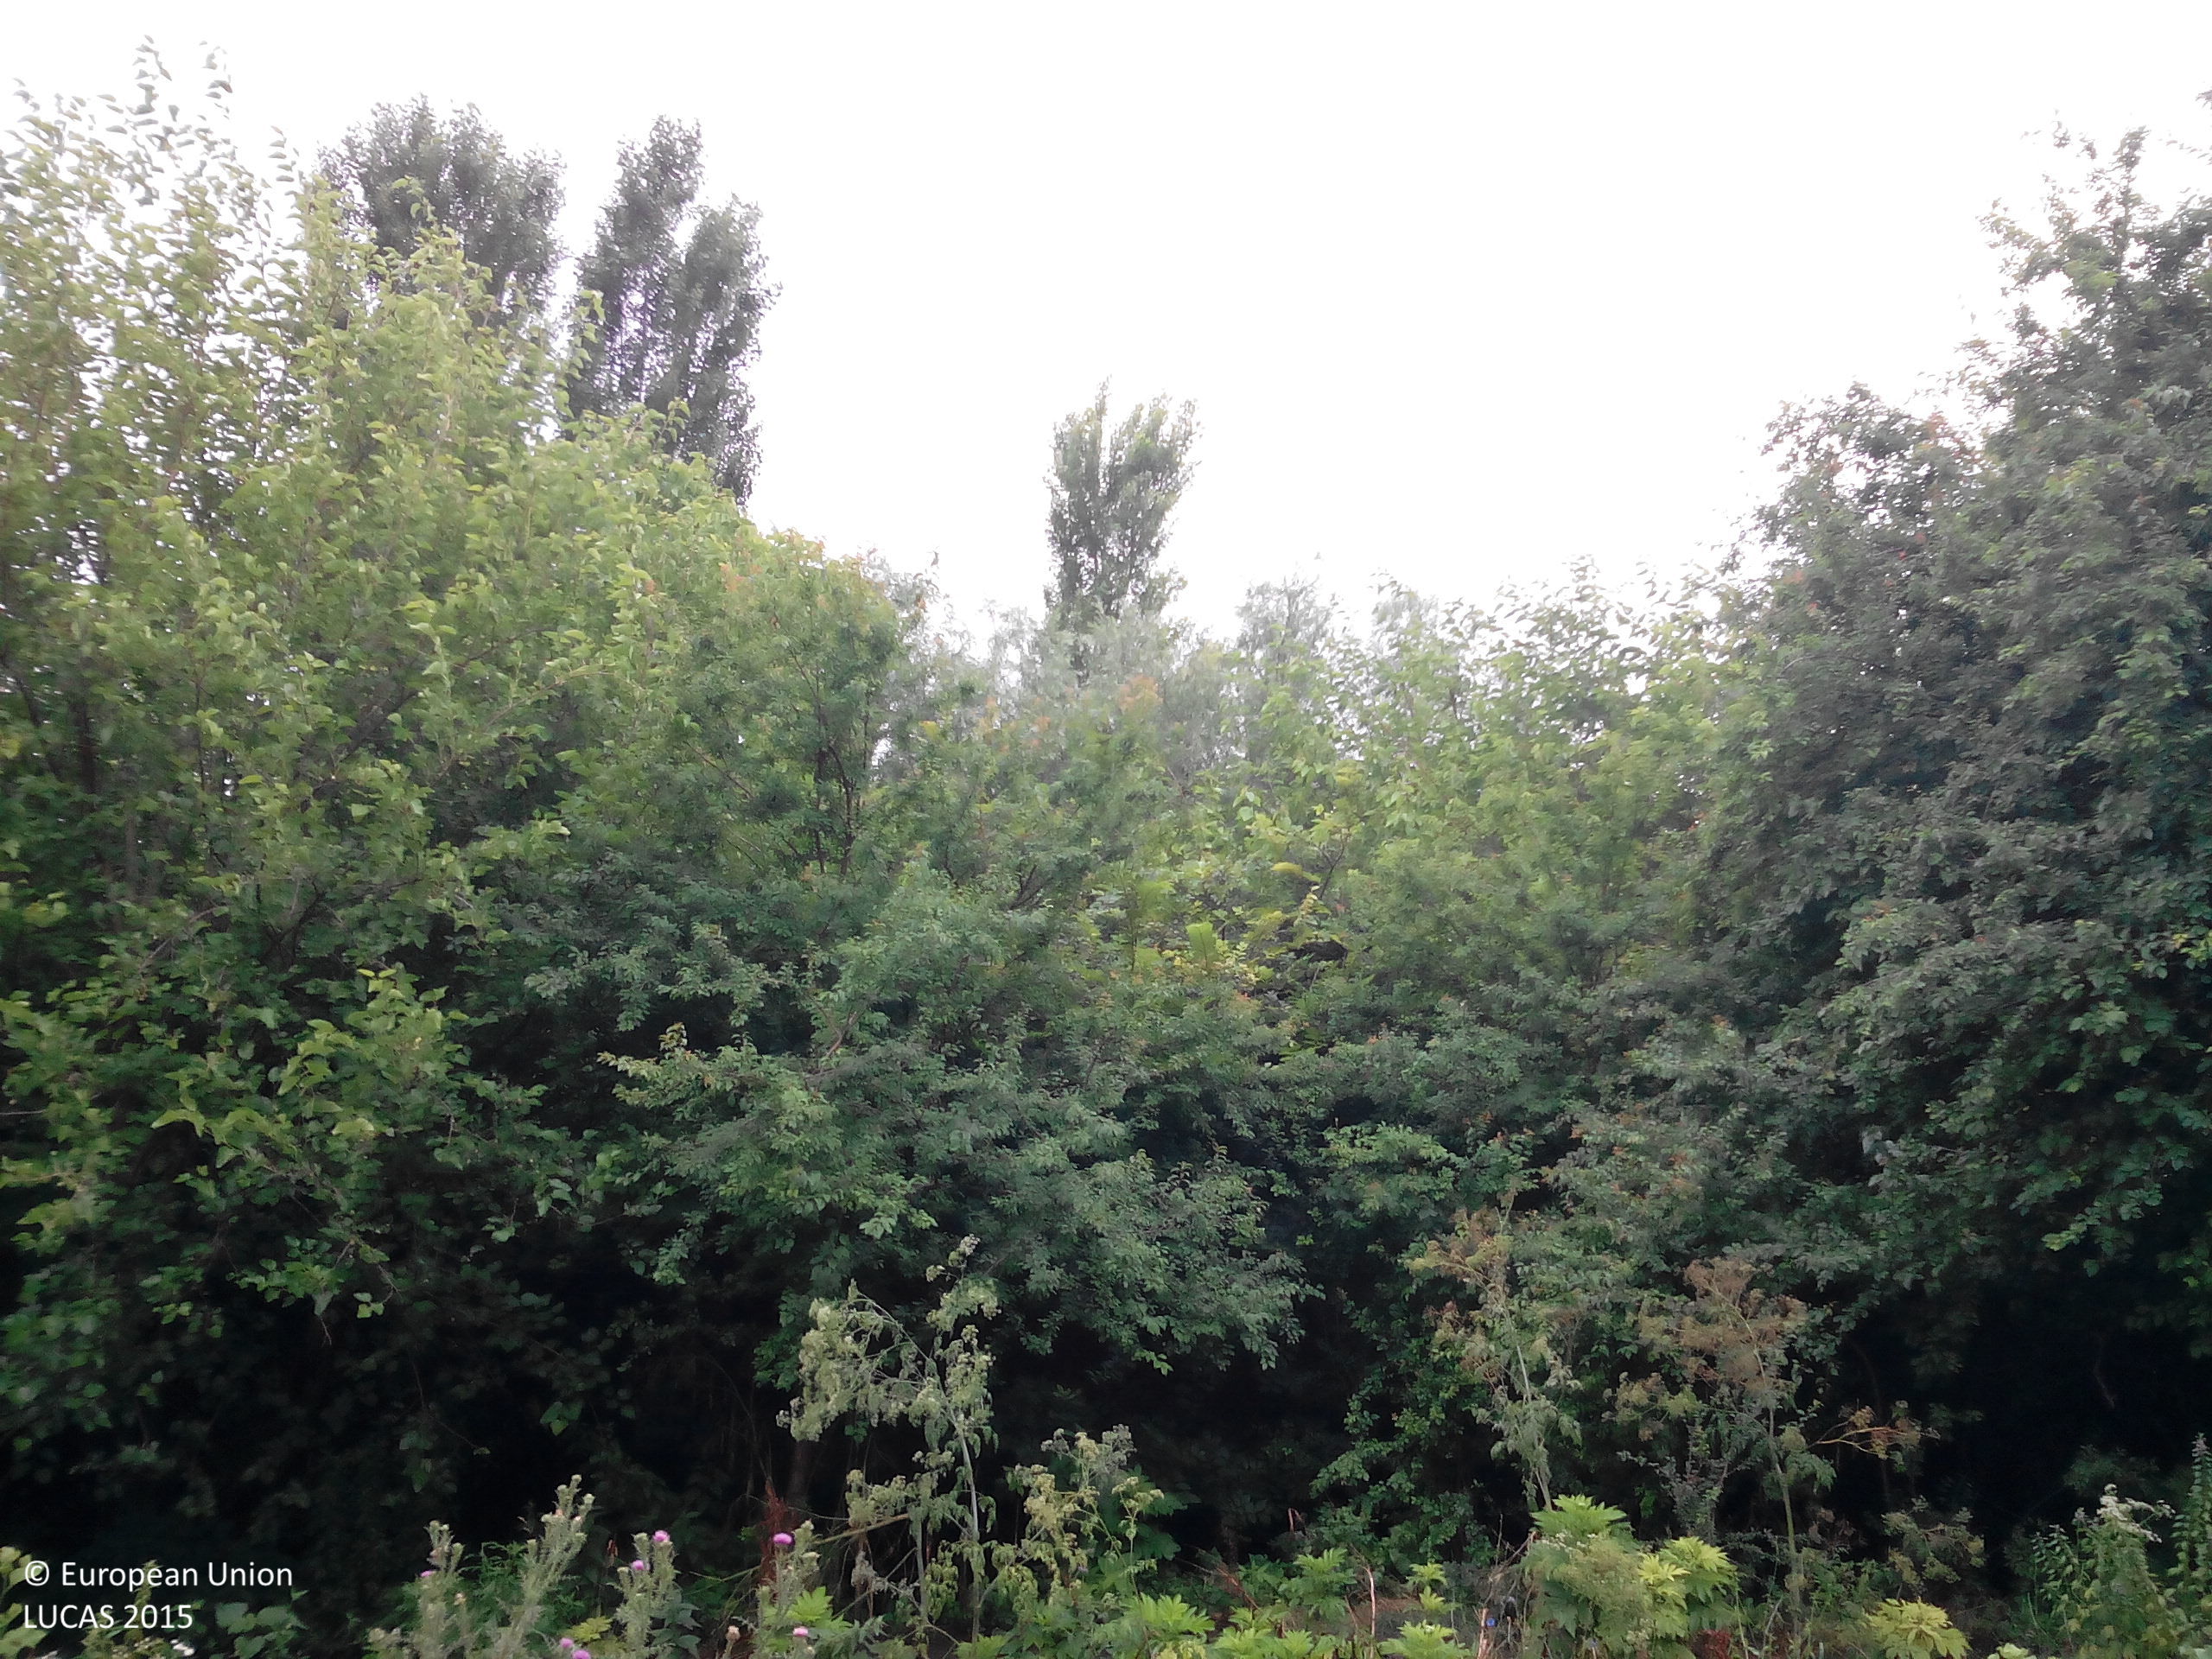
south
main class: Cropland
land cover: Maize
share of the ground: > 75 %
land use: Kitchen garden
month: July
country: BG
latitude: 43.4335
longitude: 24.1254
